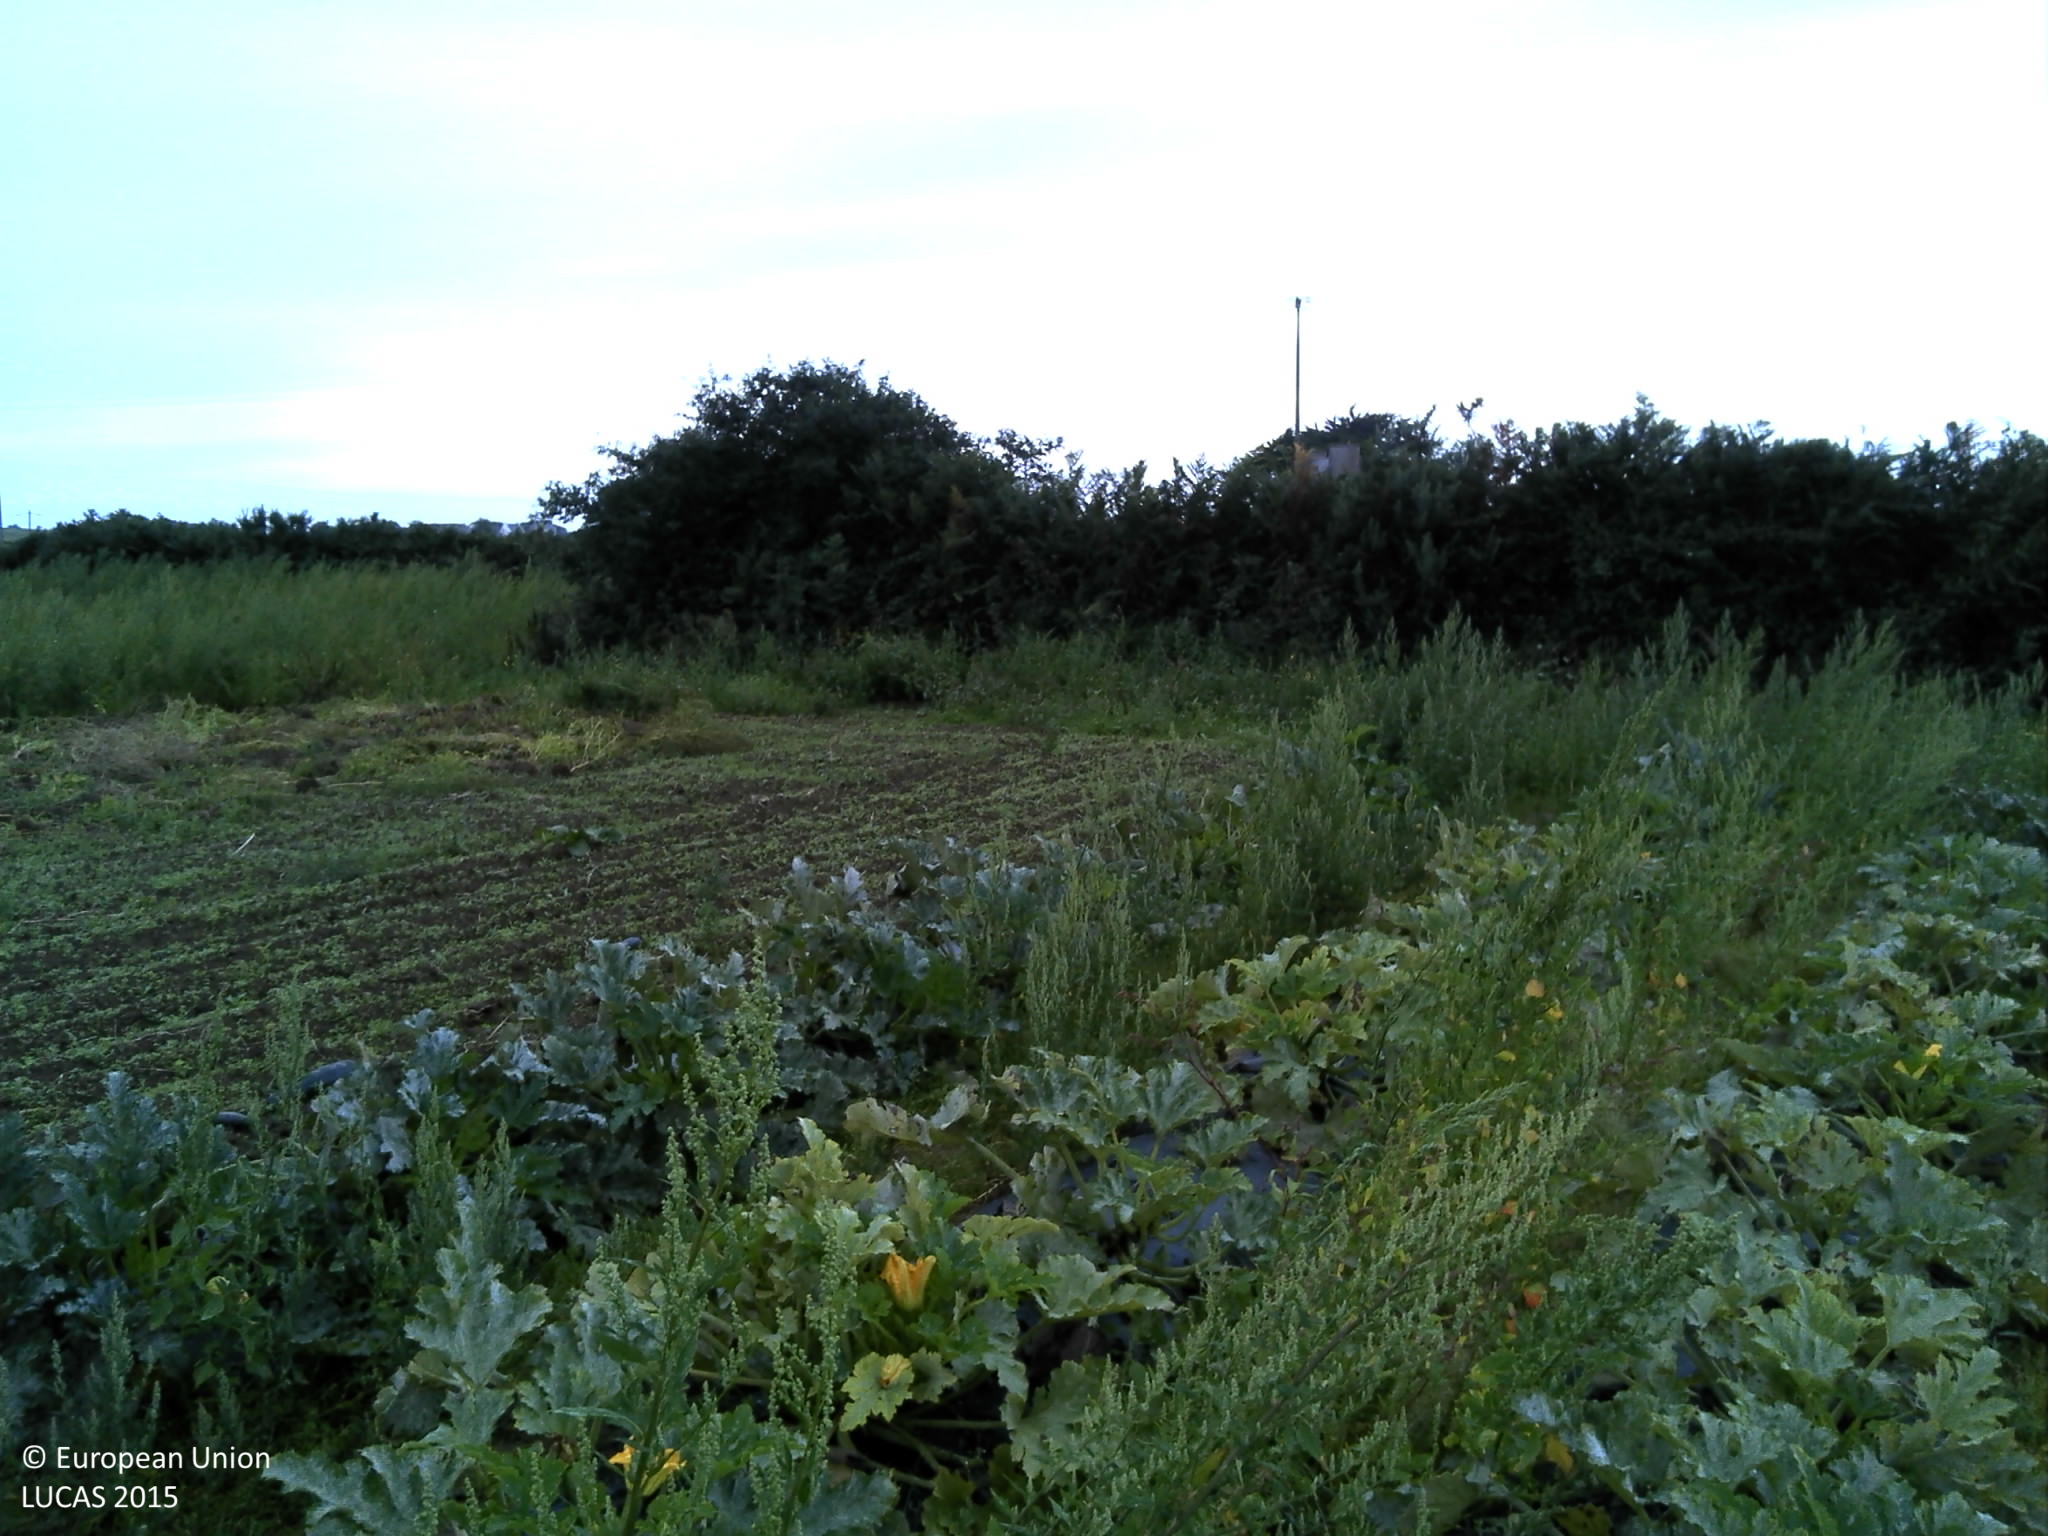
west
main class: Cropland
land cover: Other fresh vegetables
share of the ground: 50 - 75 %
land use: Agriculture (excluding fallow land and kitchen gardens)
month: August
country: FR
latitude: 48.6088
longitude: -4.5172
